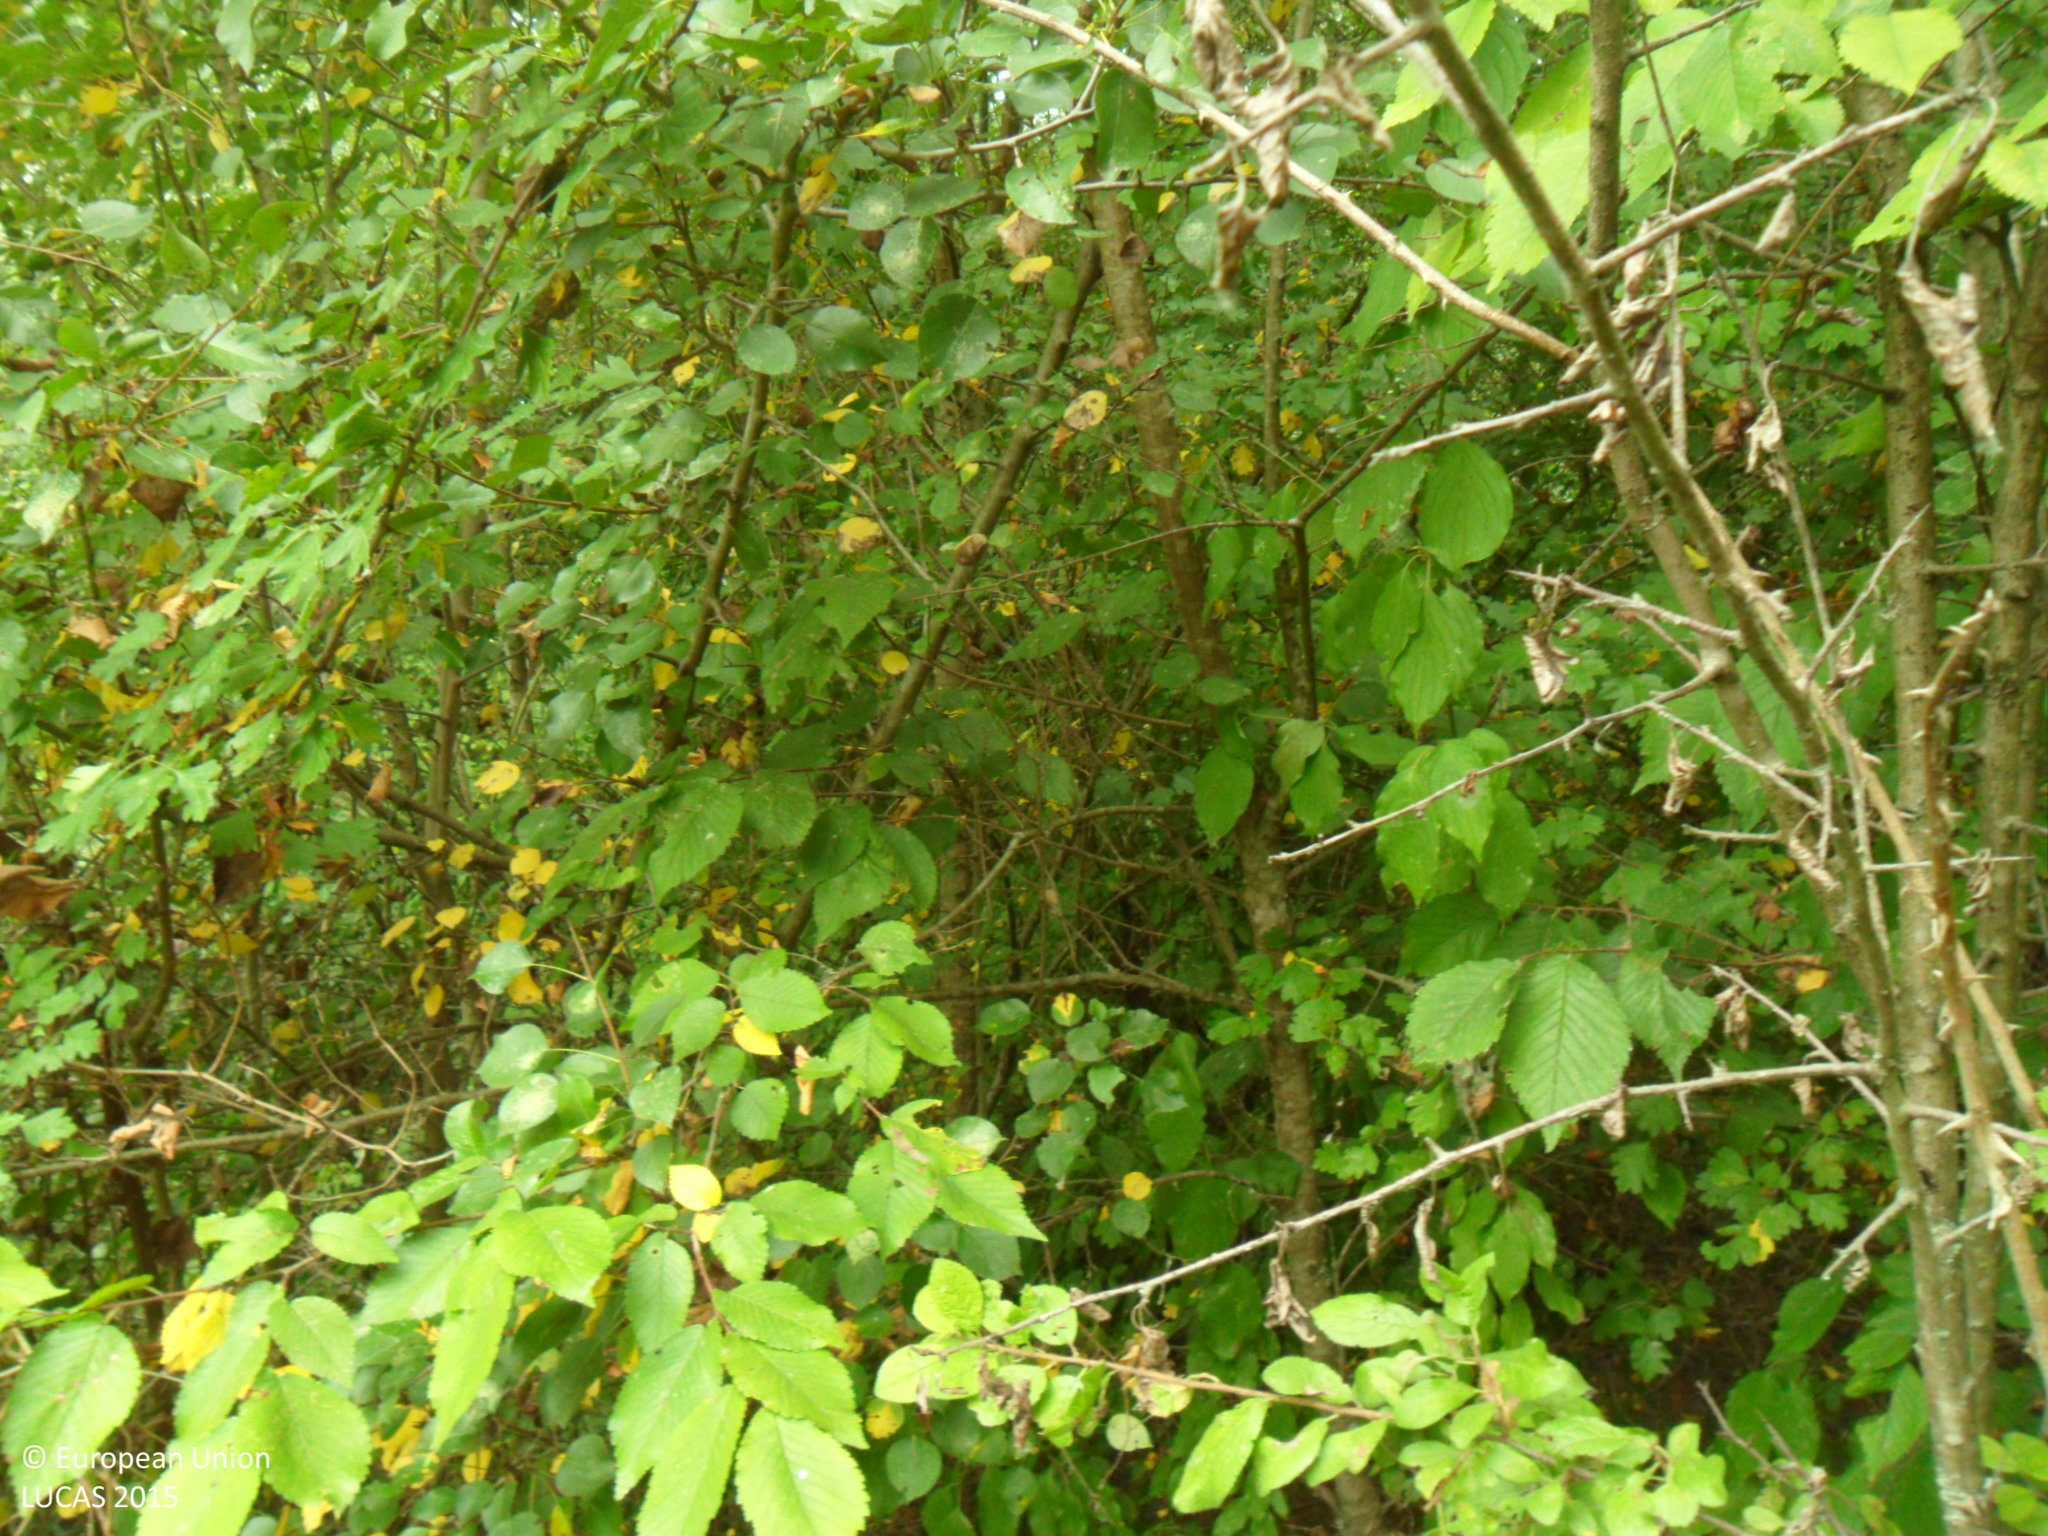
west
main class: Shrubland
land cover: Shrubland with sparse tree cover
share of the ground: > 75 %
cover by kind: shrubs 95 %, broadleaved forest trees 5 %
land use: Semi-natural and natural areas not in use
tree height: > 5 m
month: August
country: BG
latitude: 43.0563
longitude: 26.7167
